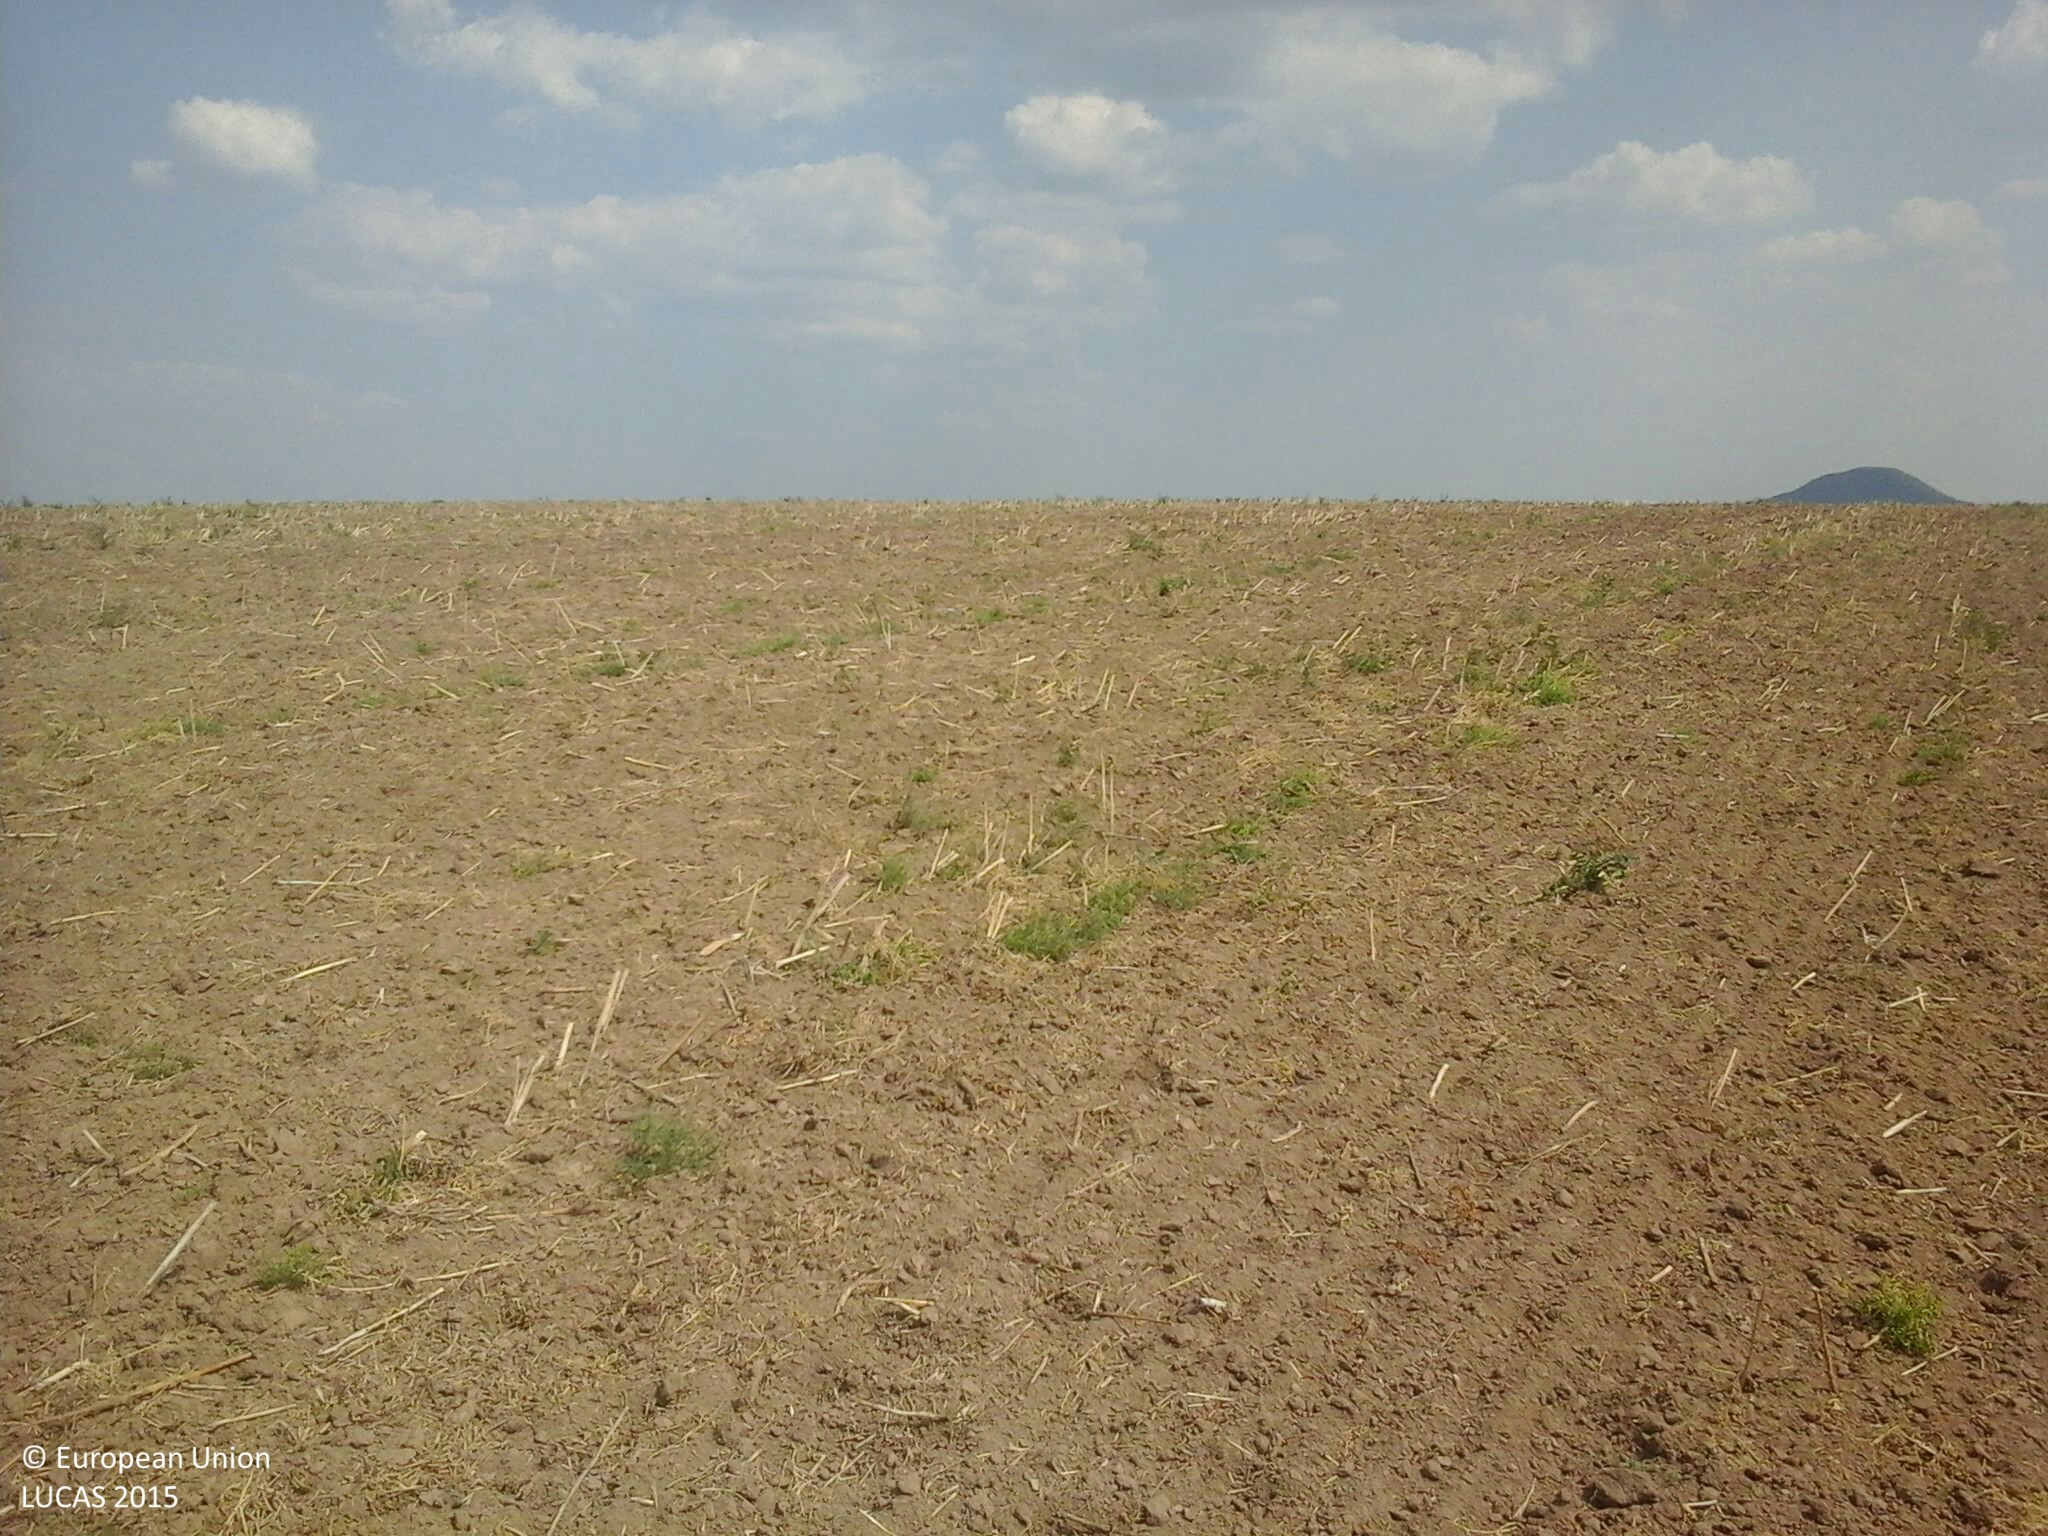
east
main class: Cropland
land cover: Rape and turnip rape
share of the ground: < 10 %
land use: Agriculture (excluding fallow land and kitchen gardens)
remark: Harvested field
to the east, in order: Rape and turnip rape
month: August
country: HU
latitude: 47.7430
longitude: 18.5908
